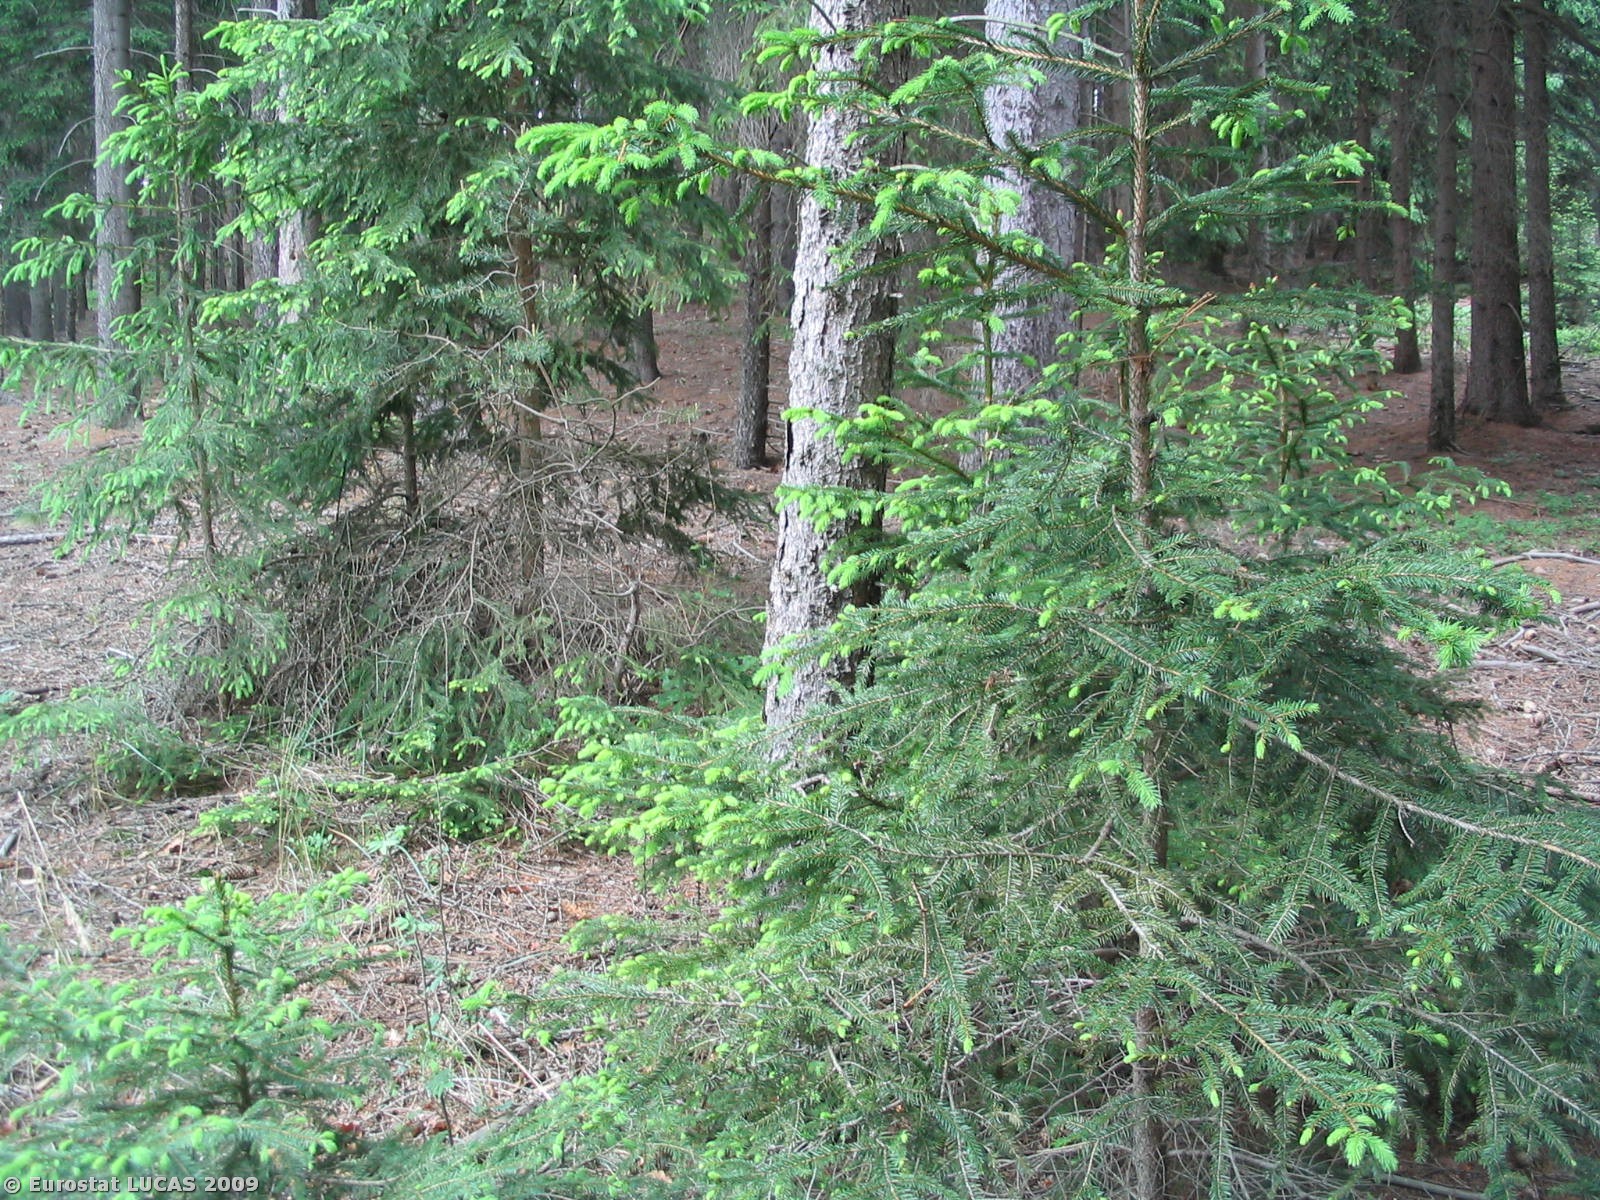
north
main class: Woodland
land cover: Coniferous woodland
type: hemiboreal forest and nemoral coniferous forest and mixed broadleaved-coniferous forest
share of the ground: > 75 %
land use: Forestry
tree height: > 5 m
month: May
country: CZ
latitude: 49.4409
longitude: 16.4752
